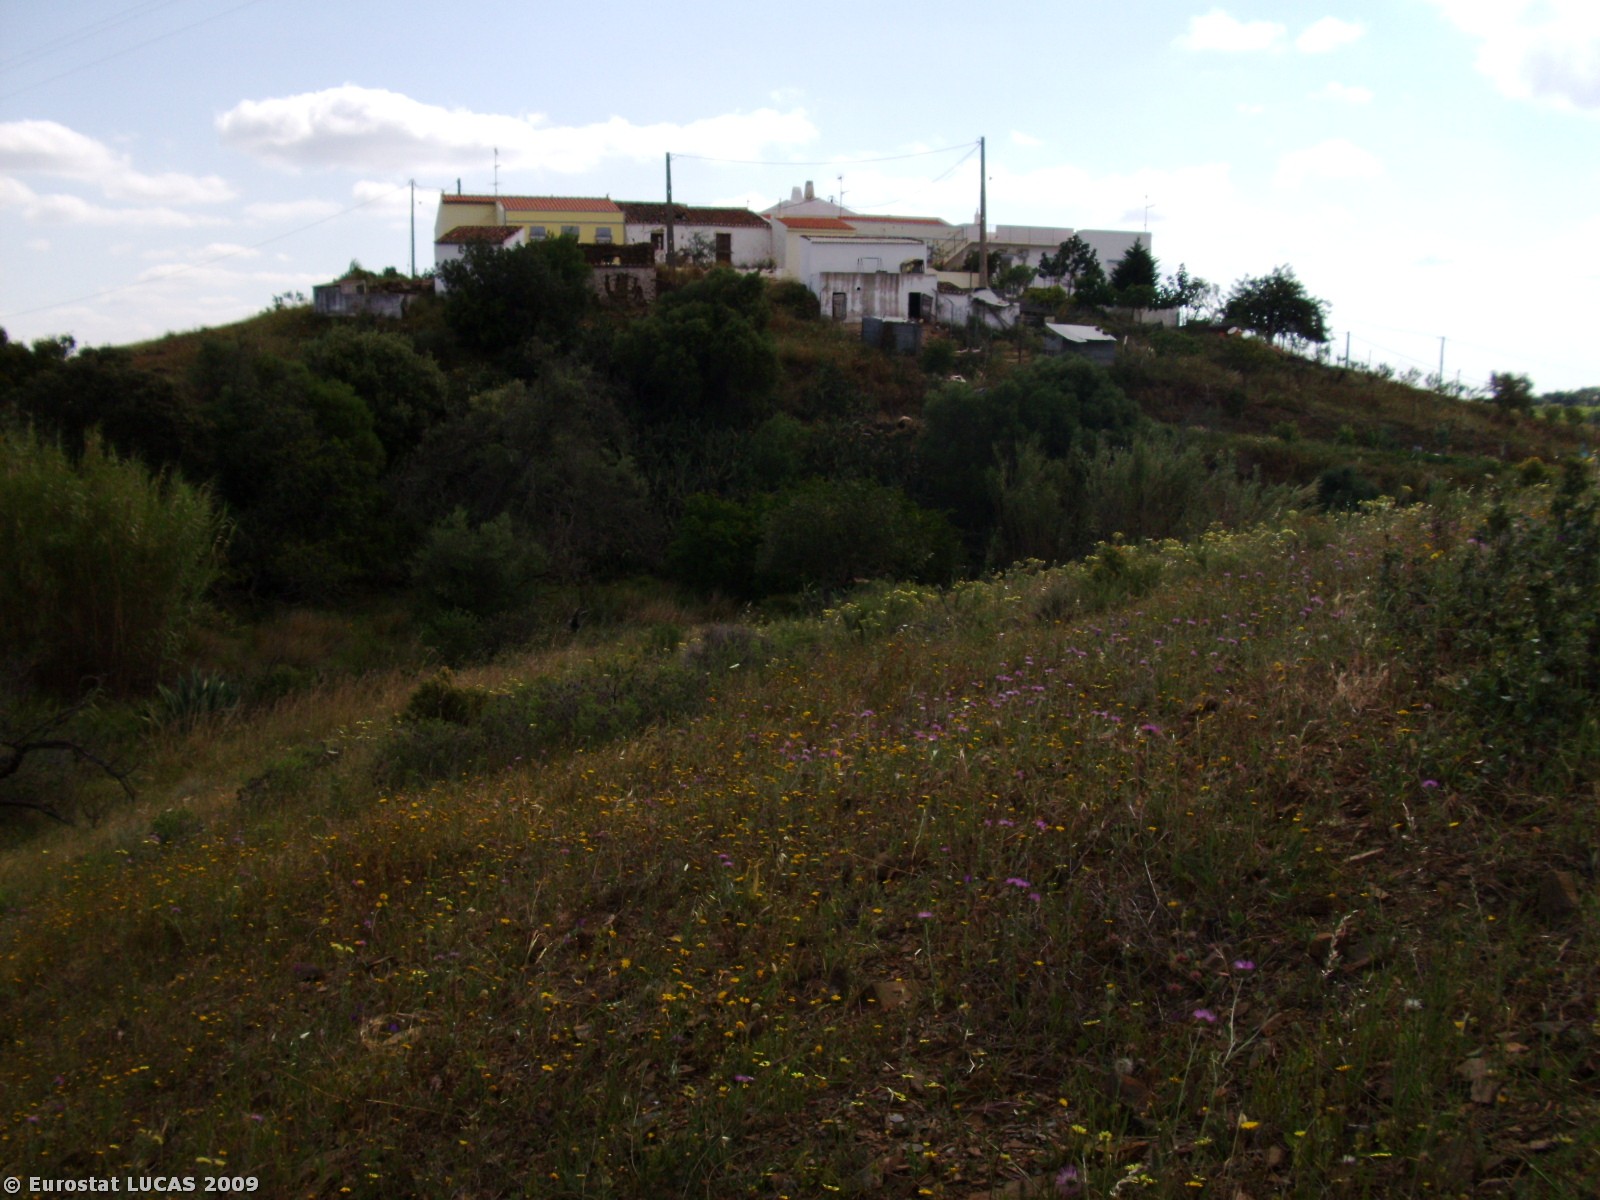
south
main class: Cropland
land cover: Olive groves
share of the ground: < 10 %
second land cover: Spontaneously vegetated surfaces
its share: > 75 %
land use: Agriculture (excluding fallow land and kitchen gardens)
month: April
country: PT
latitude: 37.1981
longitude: -7.5226
